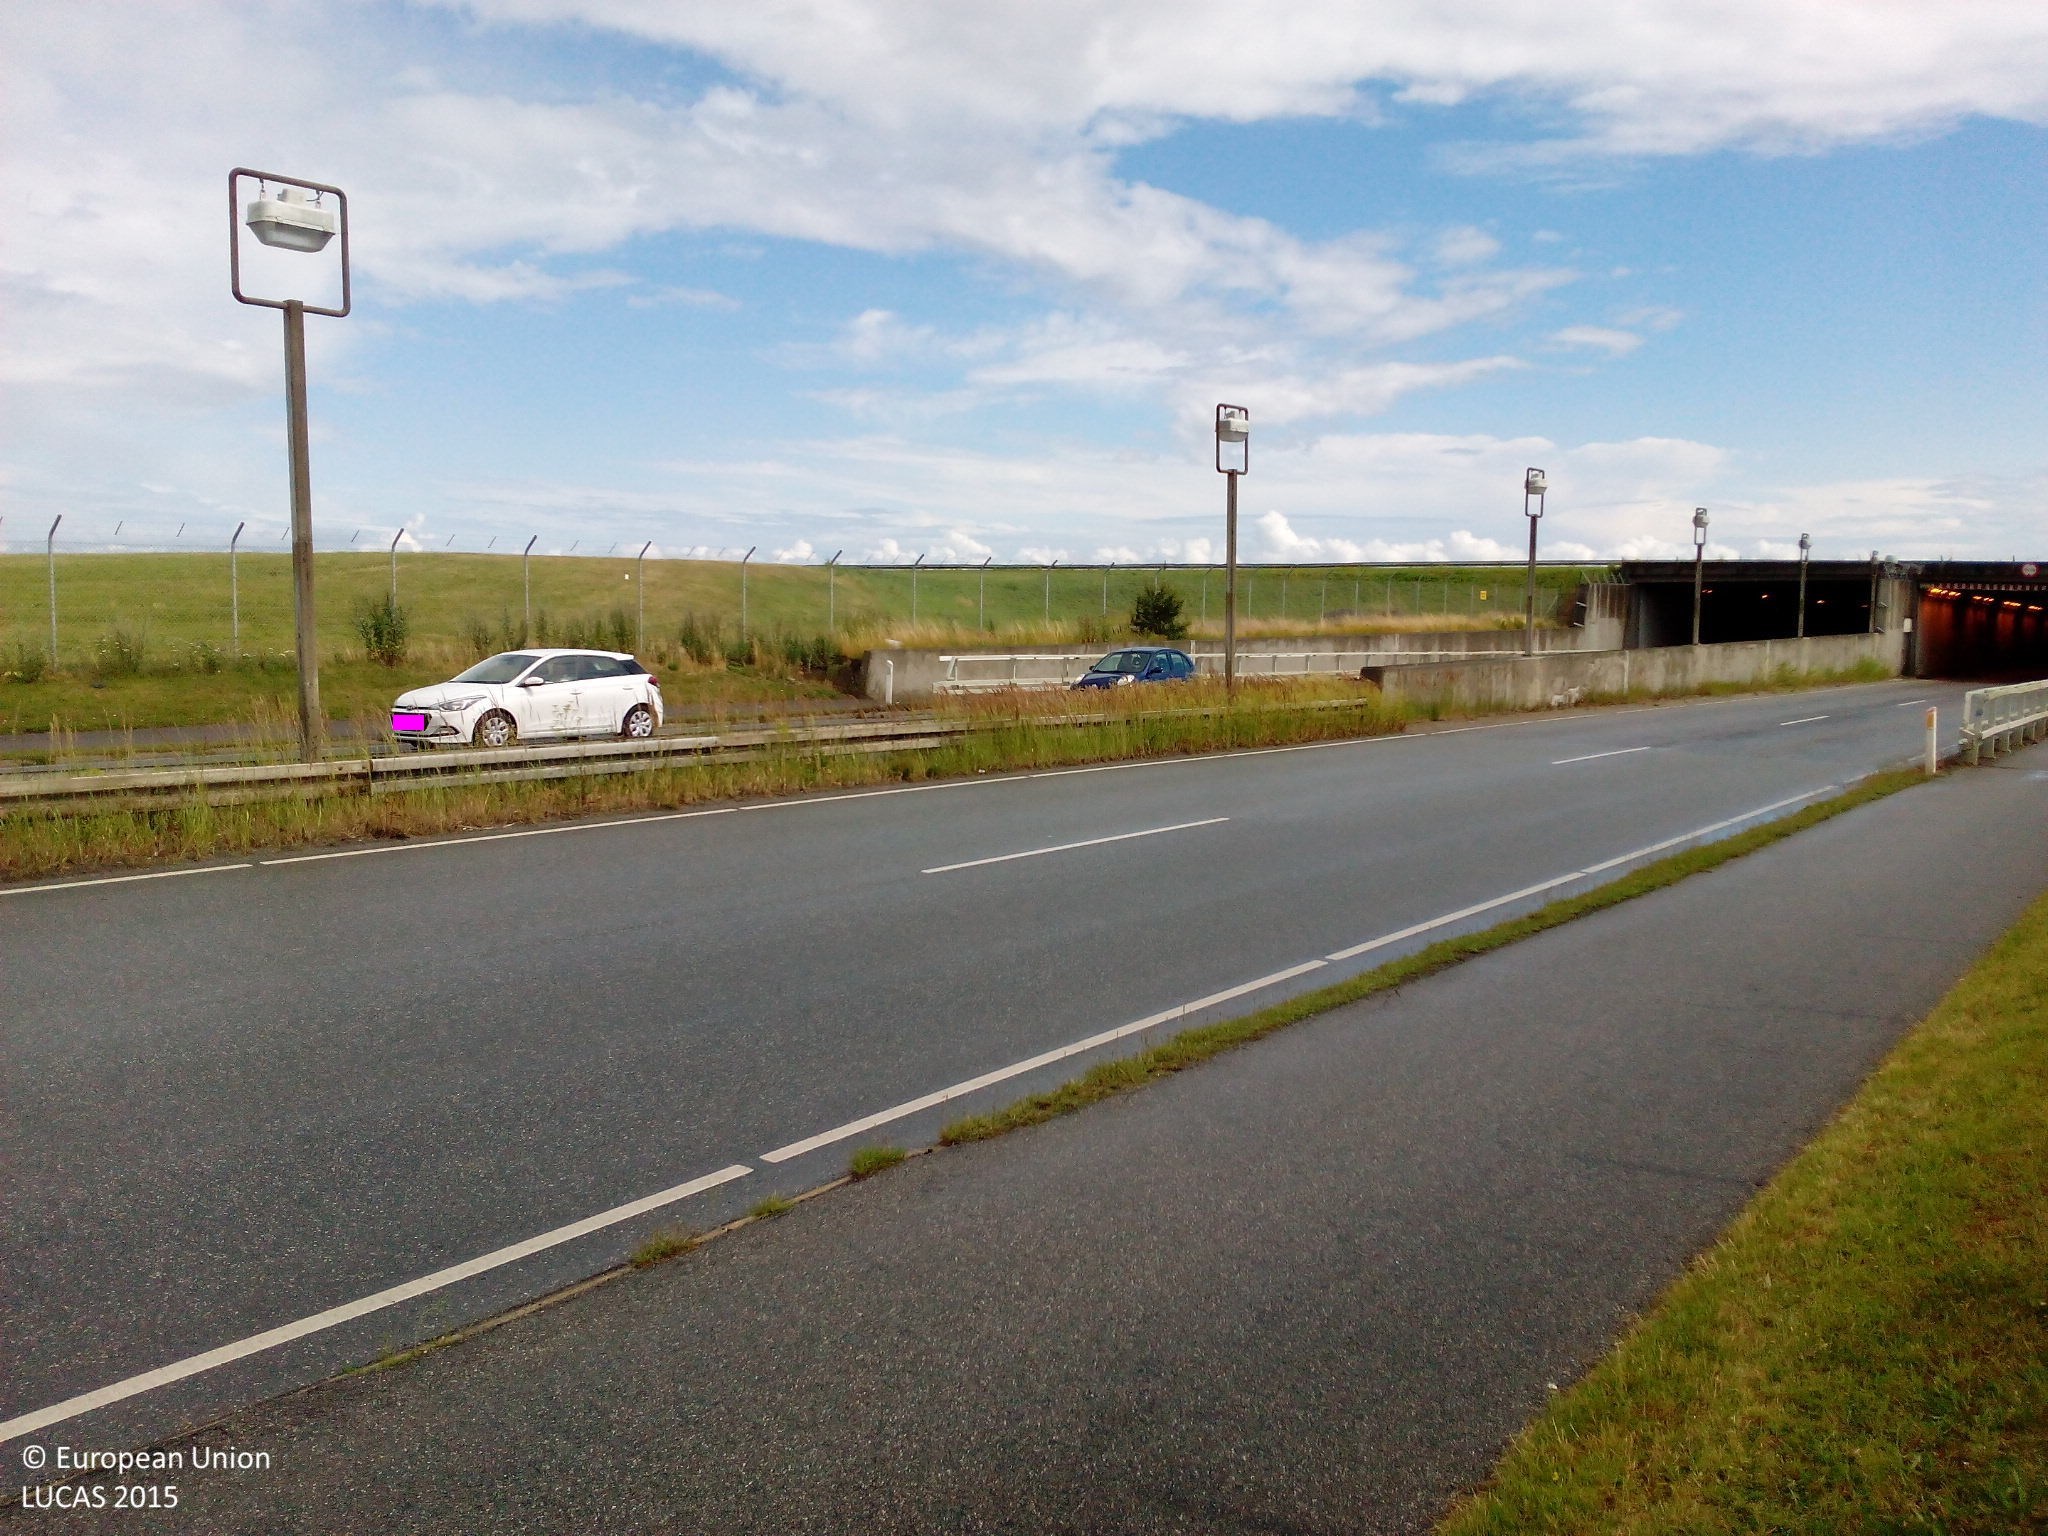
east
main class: Grassland
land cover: Grassland without tree/shrub cover
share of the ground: > 75 %
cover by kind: herbaceous plants 100 %
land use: Air transport
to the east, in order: Grassland without tree/shrub cover; Tracks; Grassland without tree/shrub cover; Paved roads, cycling and walking lanes; Grassland without tree/shrub cover; Paved roads, cycling and walking lanes
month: July
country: DK
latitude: 55.6036
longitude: 12.6170
